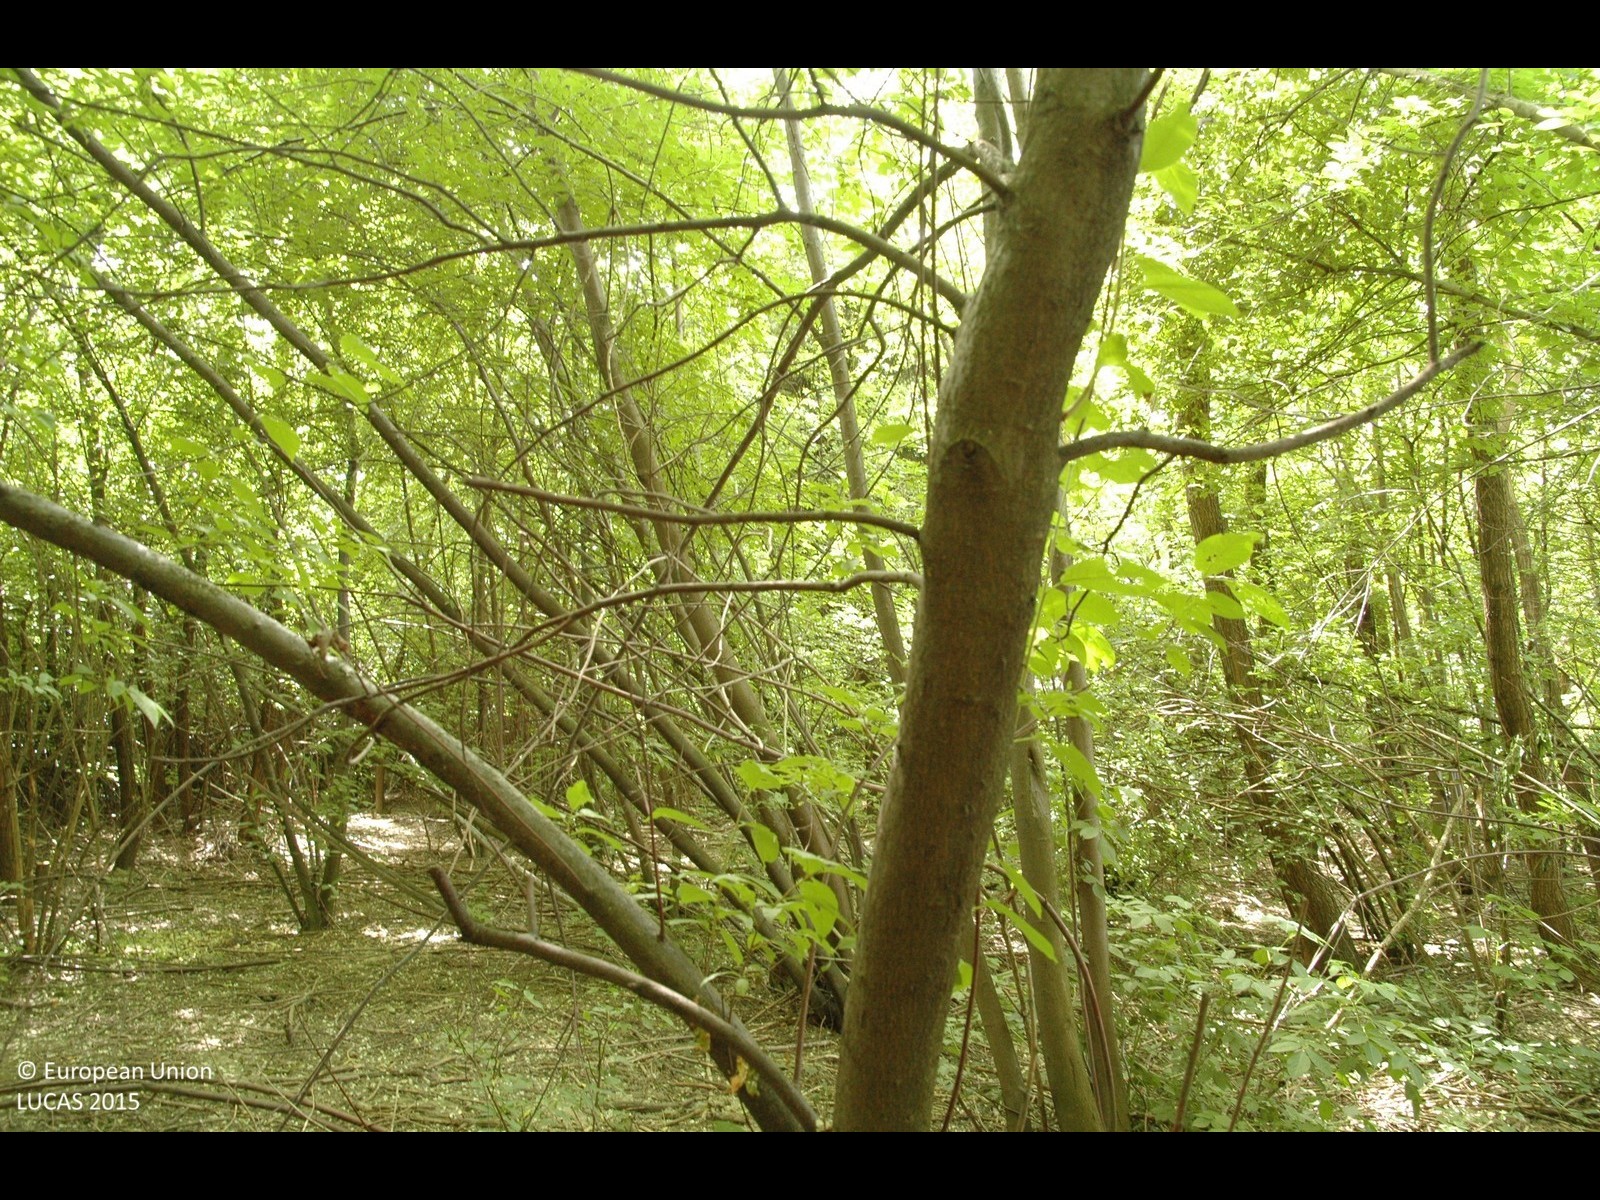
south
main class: Woodland
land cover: Broadleaved woodland
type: floodplain forest
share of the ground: > 75 %
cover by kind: broadleaved forest trees 90 %, shrubs 5 %, herbaceous plants 5 %
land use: Forestry
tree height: > 5 m
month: May
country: HR
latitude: 46.3024
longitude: 16.4271
